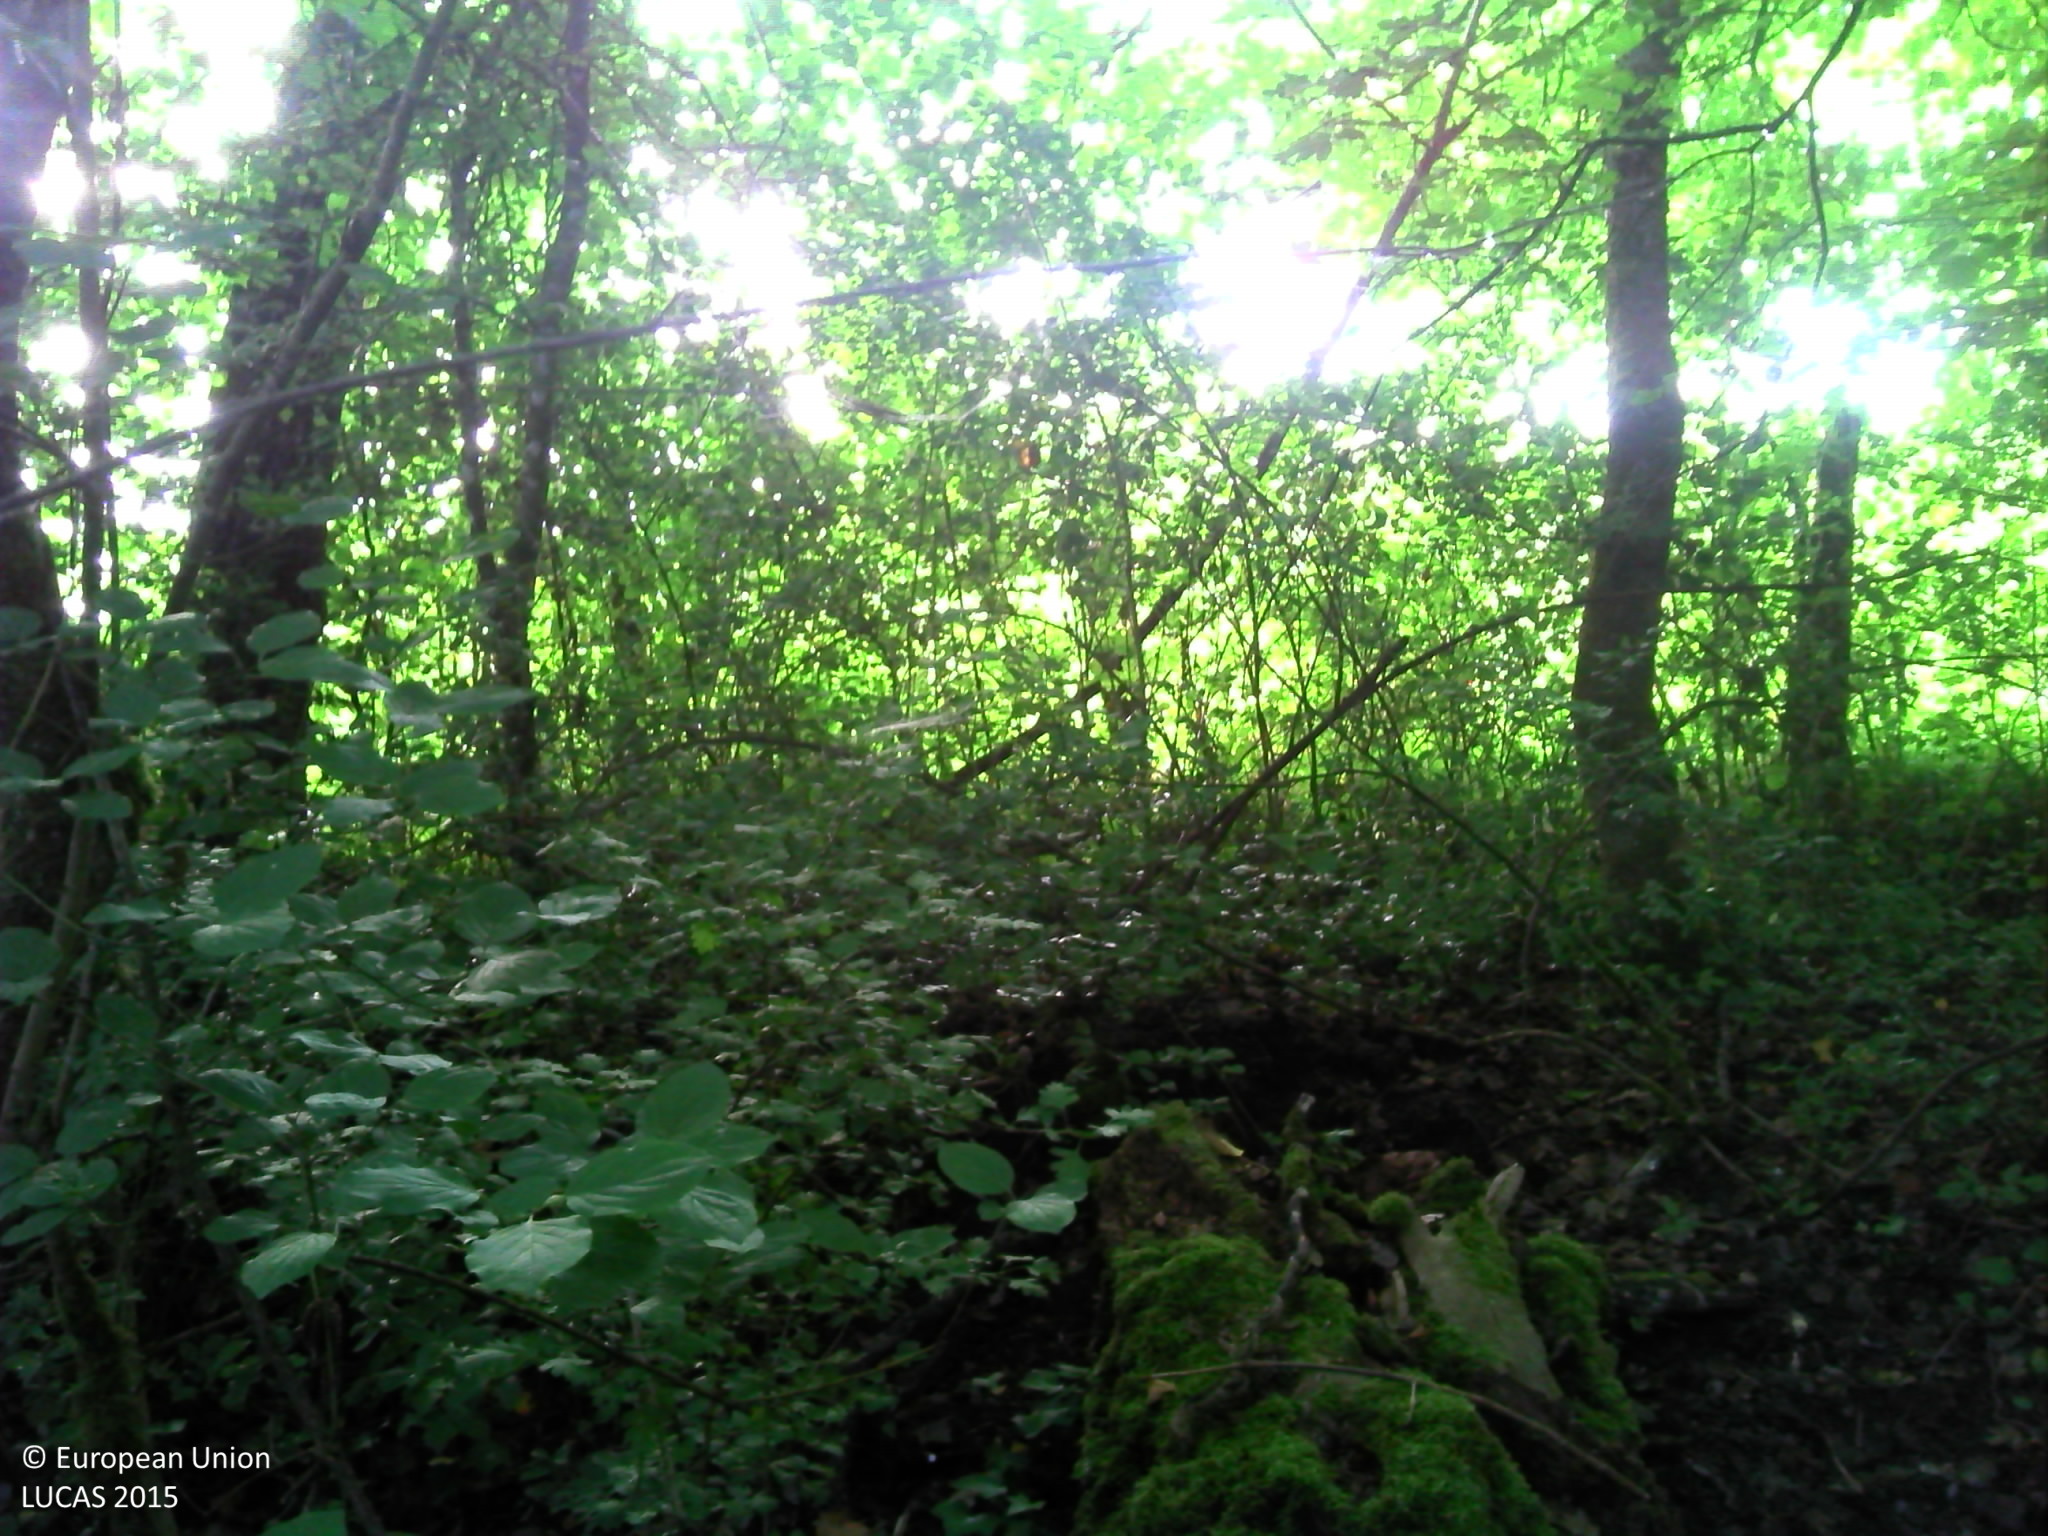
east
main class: Woodland
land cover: Broadleaved woodland
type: beech forest
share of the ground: > 75 %
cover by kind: broadleaved forest trees 90 %, herbaceous plants 10 %
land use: Forestry
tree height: > 5 m
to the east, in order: Broadleaved woodland; Fences; Other fruit trees and berries; Fences; Grassland without tree/shrub cover; Fences; Grassland without tree/shrub cover; Tracks; Fences; Grassland without tree/shrub cover; Fences; Grassland without tree/shrub cover
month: June
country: FR
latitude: 47.7428
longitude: 6.1735
